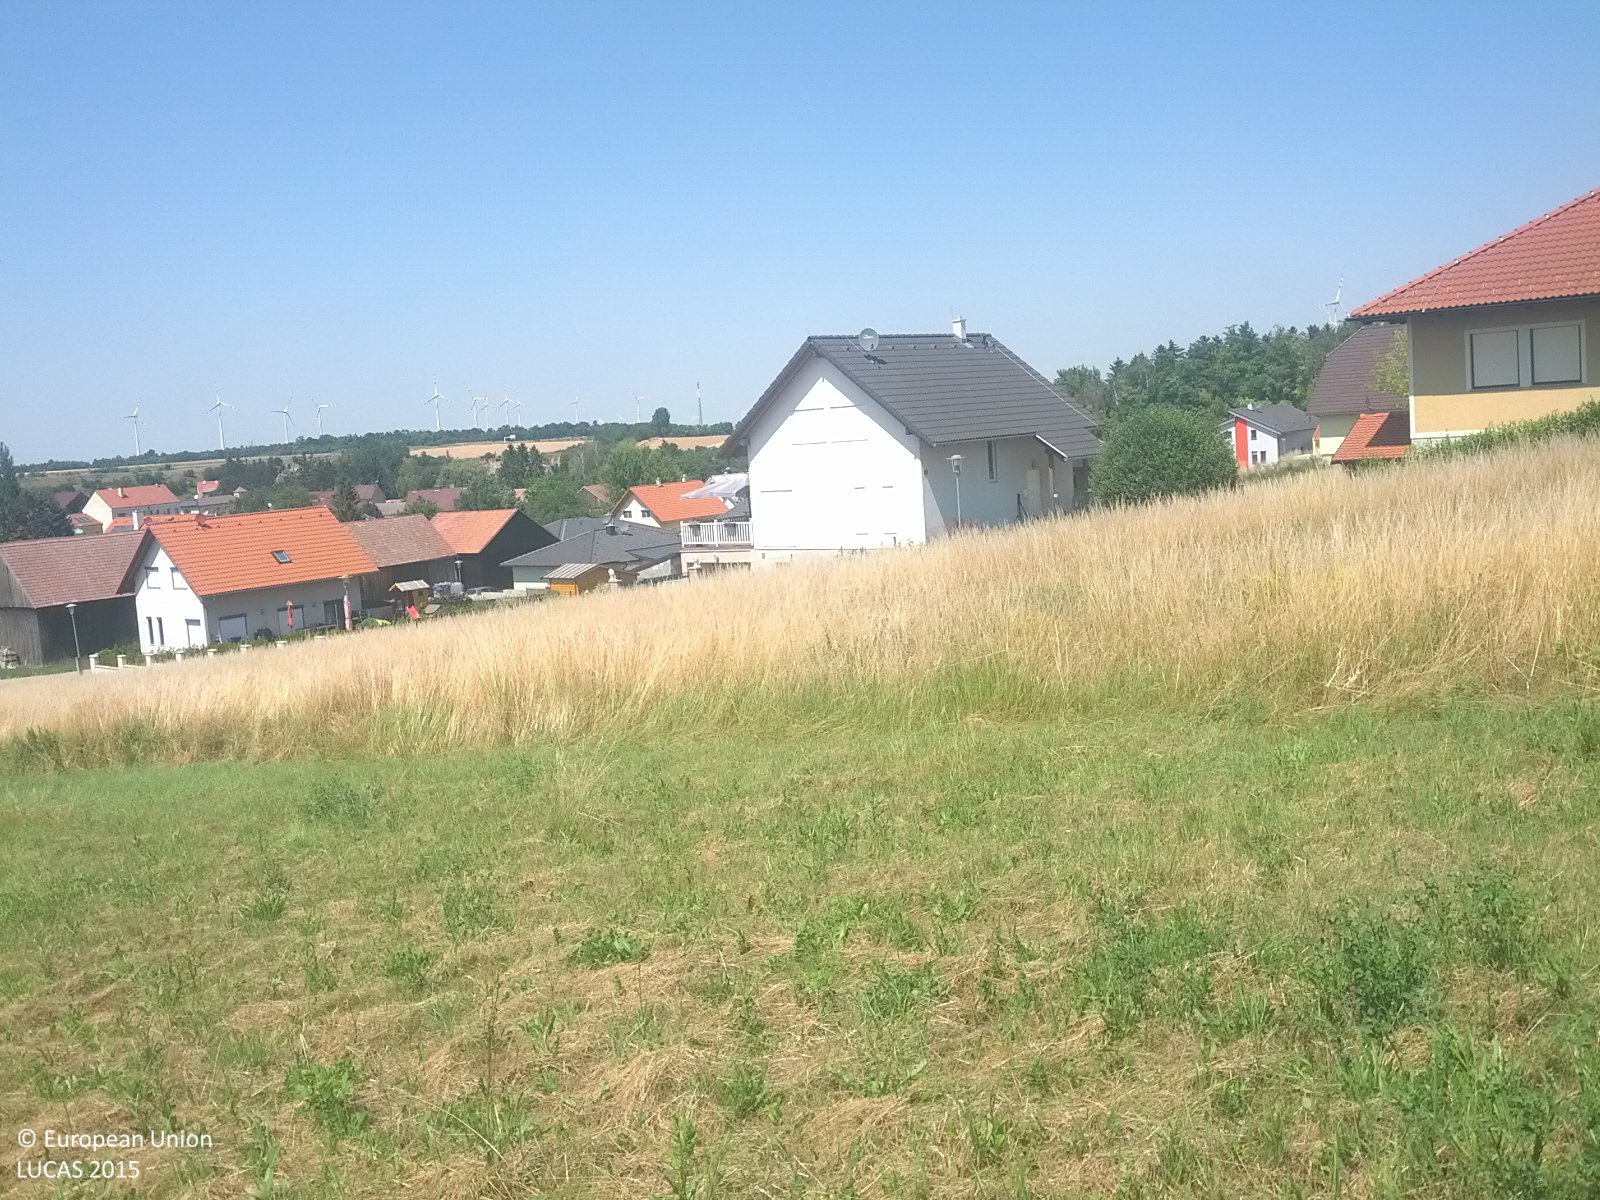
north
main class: Grassland
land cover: Grassland without tree/shrub cover
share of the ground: > 75 %
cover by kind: herbaceous plants 100 %
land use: Agriculture (excluding fallow land and kitchen gardens)
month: July
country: AT
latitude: 48.5116
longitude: 16.6260
